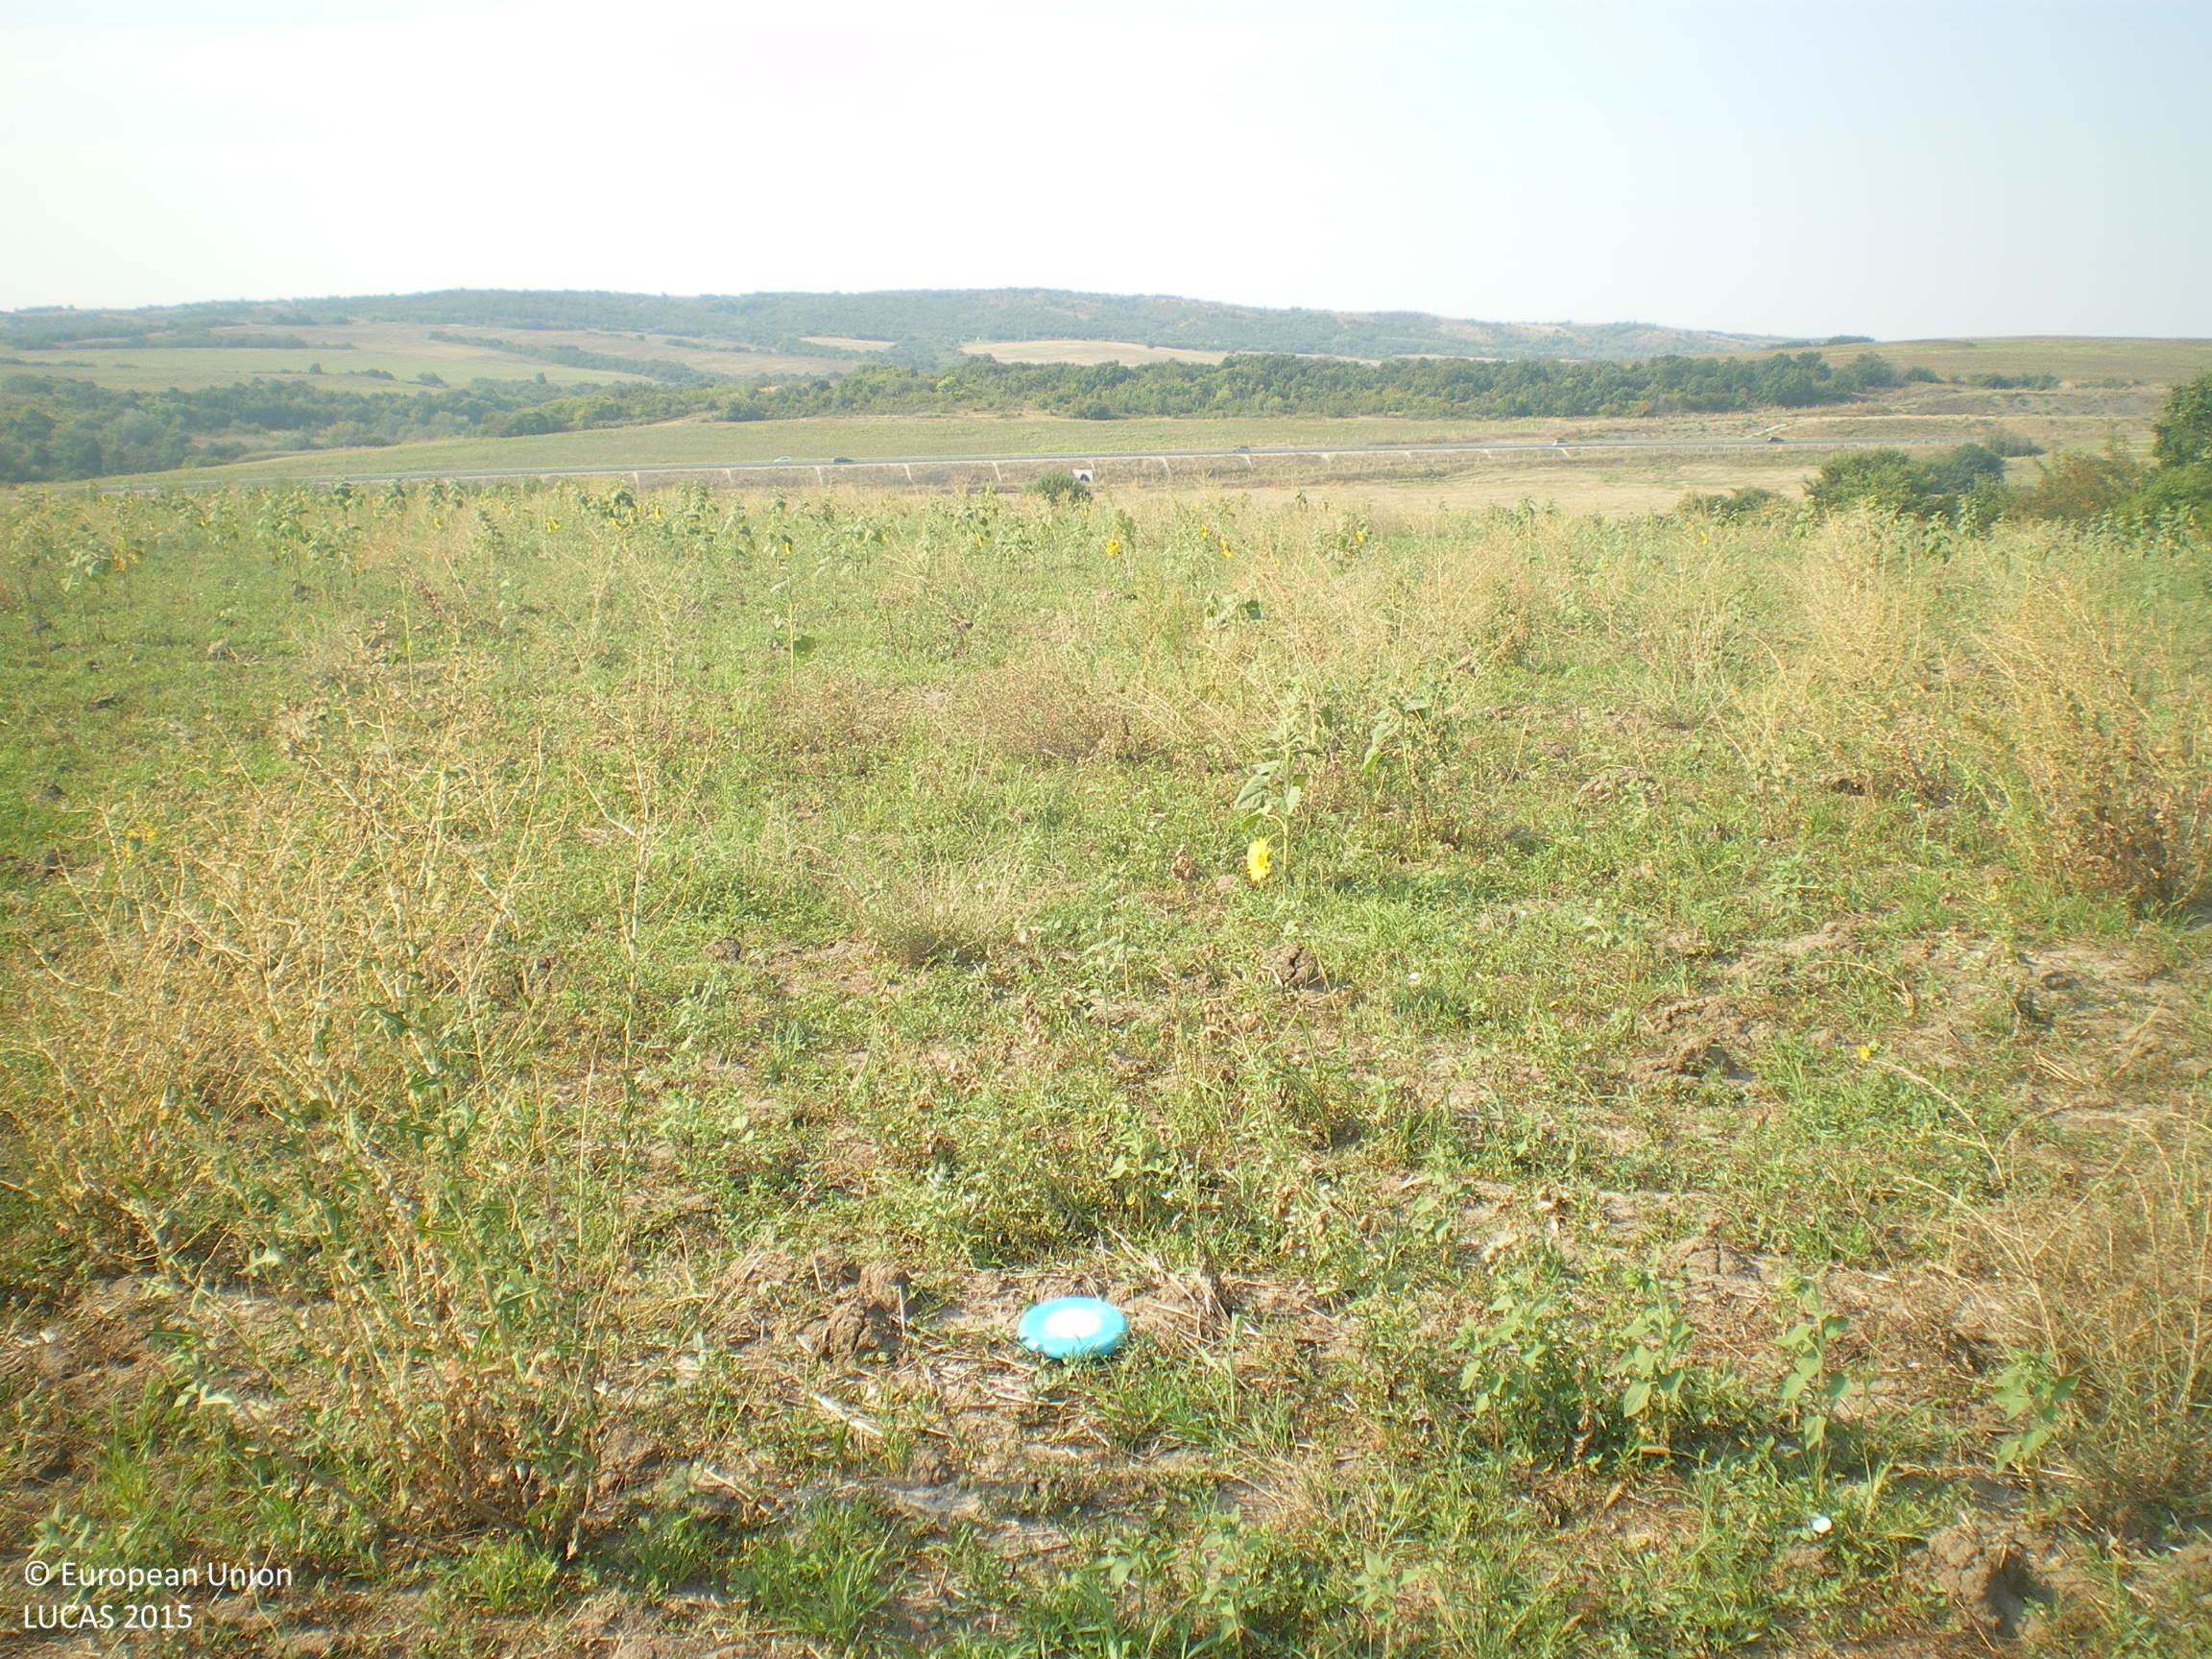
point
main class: Cropland
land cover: Sunflower
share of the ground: < 10 %
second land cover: Spontaneously vegetated surfaces
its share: > 75 %
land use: Agriculture (excluding fallow land and kitchen gardens)
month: August
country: BG
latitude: 41.9637
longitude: 25.8654
